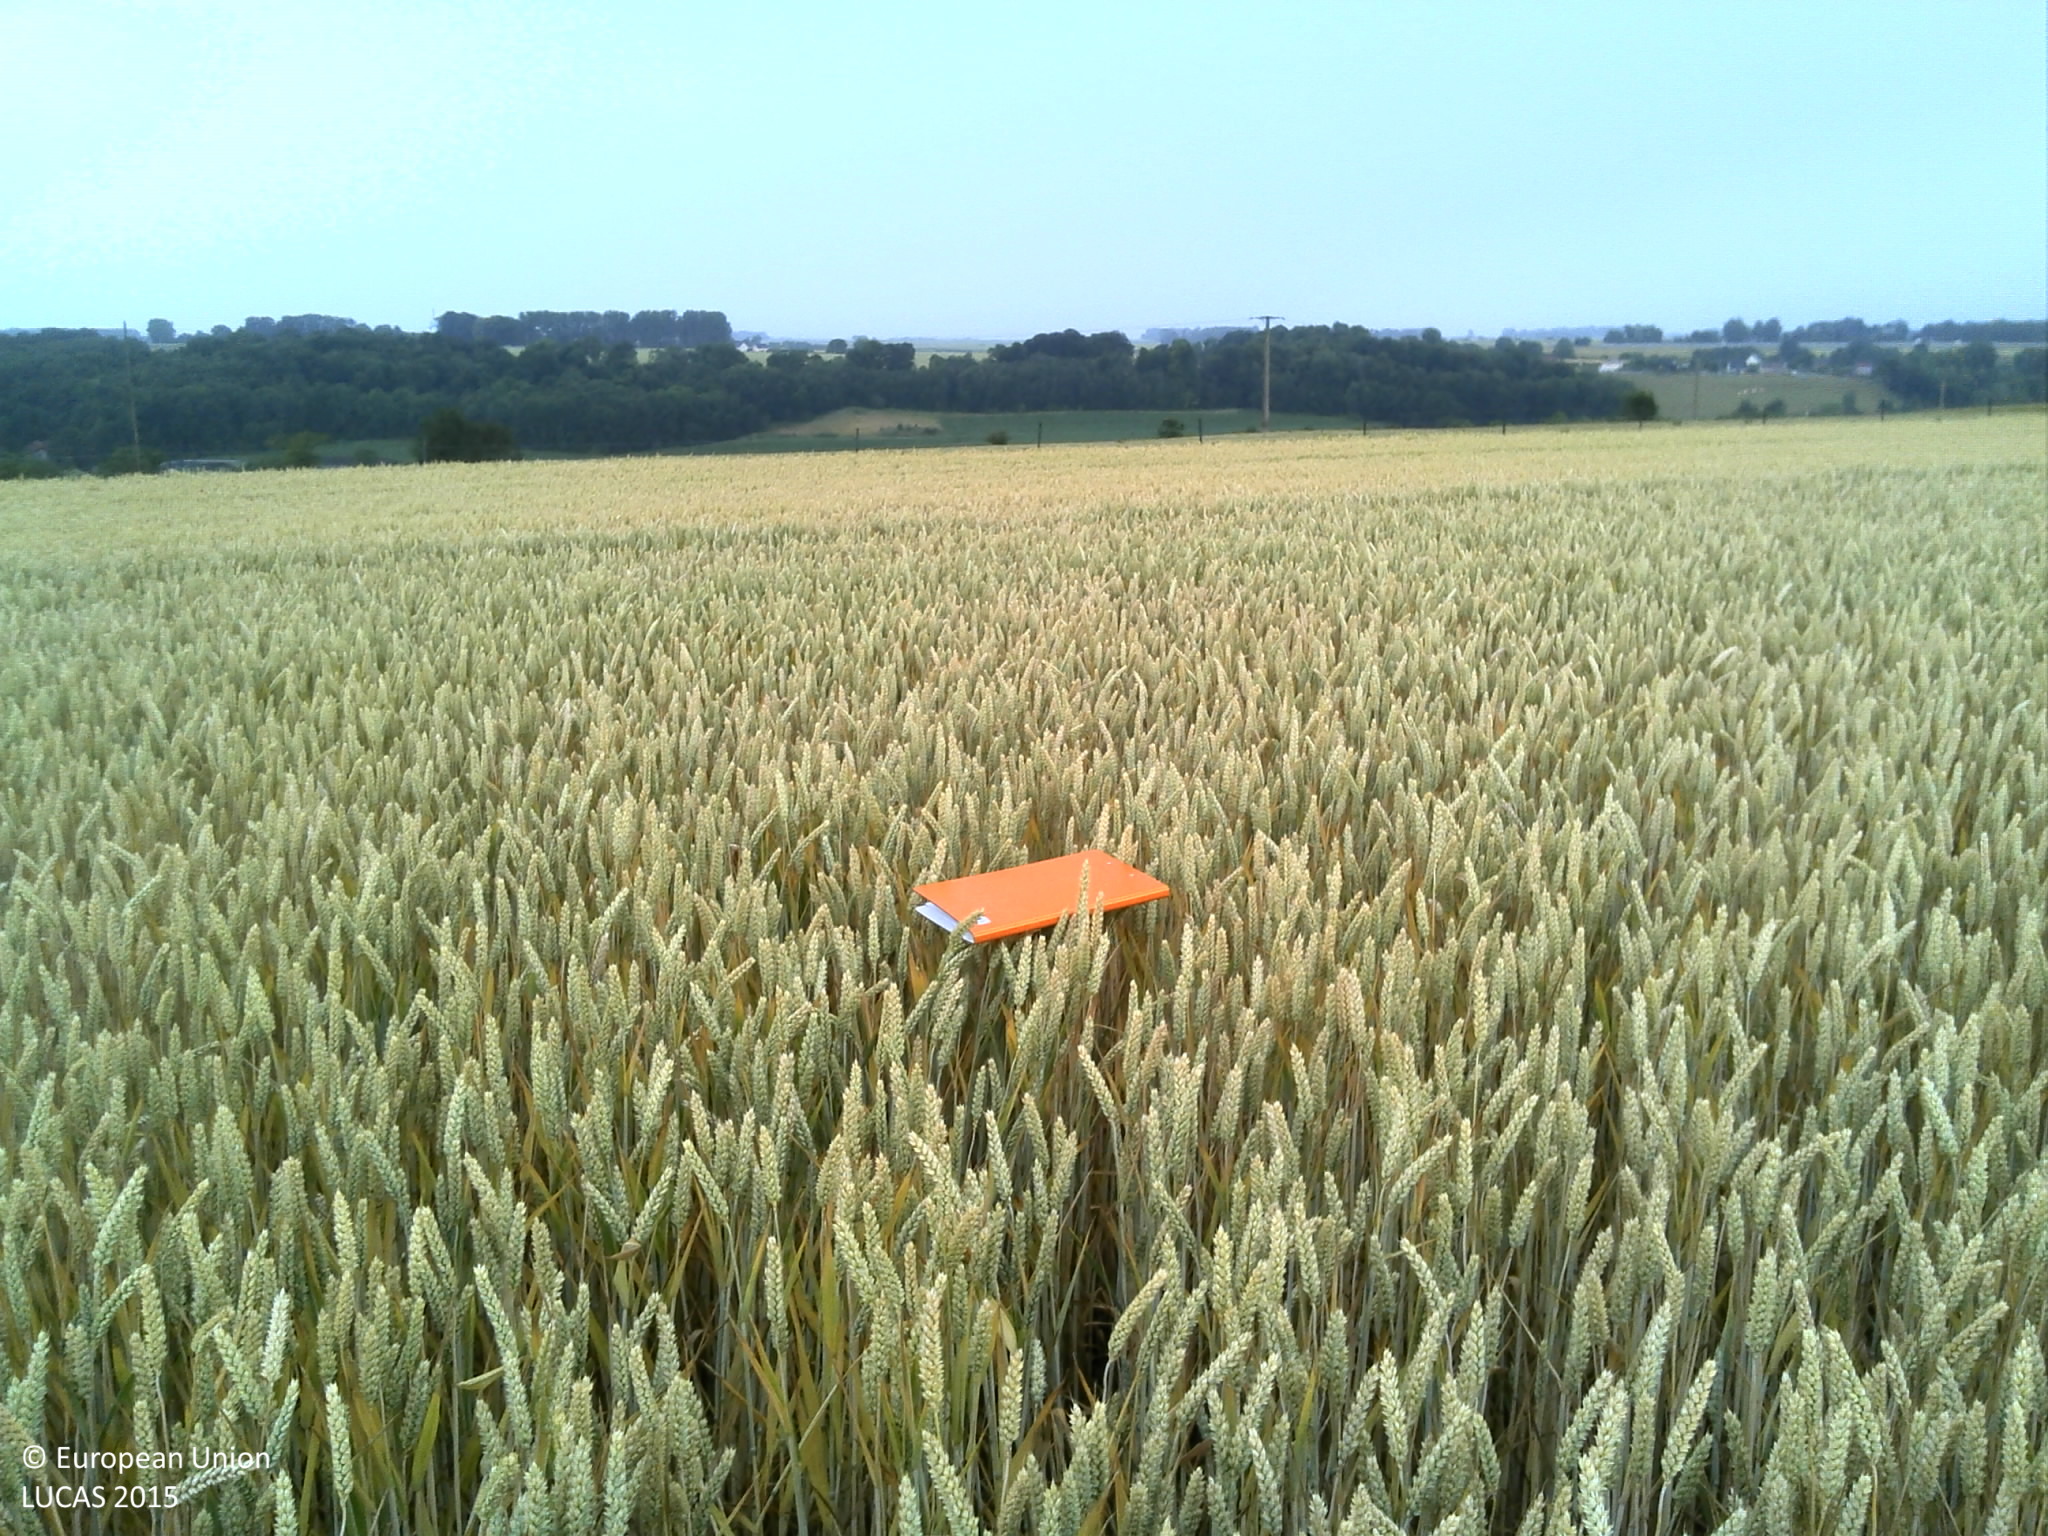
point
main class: Cropland
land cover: Common wheat
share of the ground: > 75 %
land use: Agriculture (excluding fallow land and kitchen gardens)
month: July
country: FR
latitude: 49.8351
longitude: 1.0938
